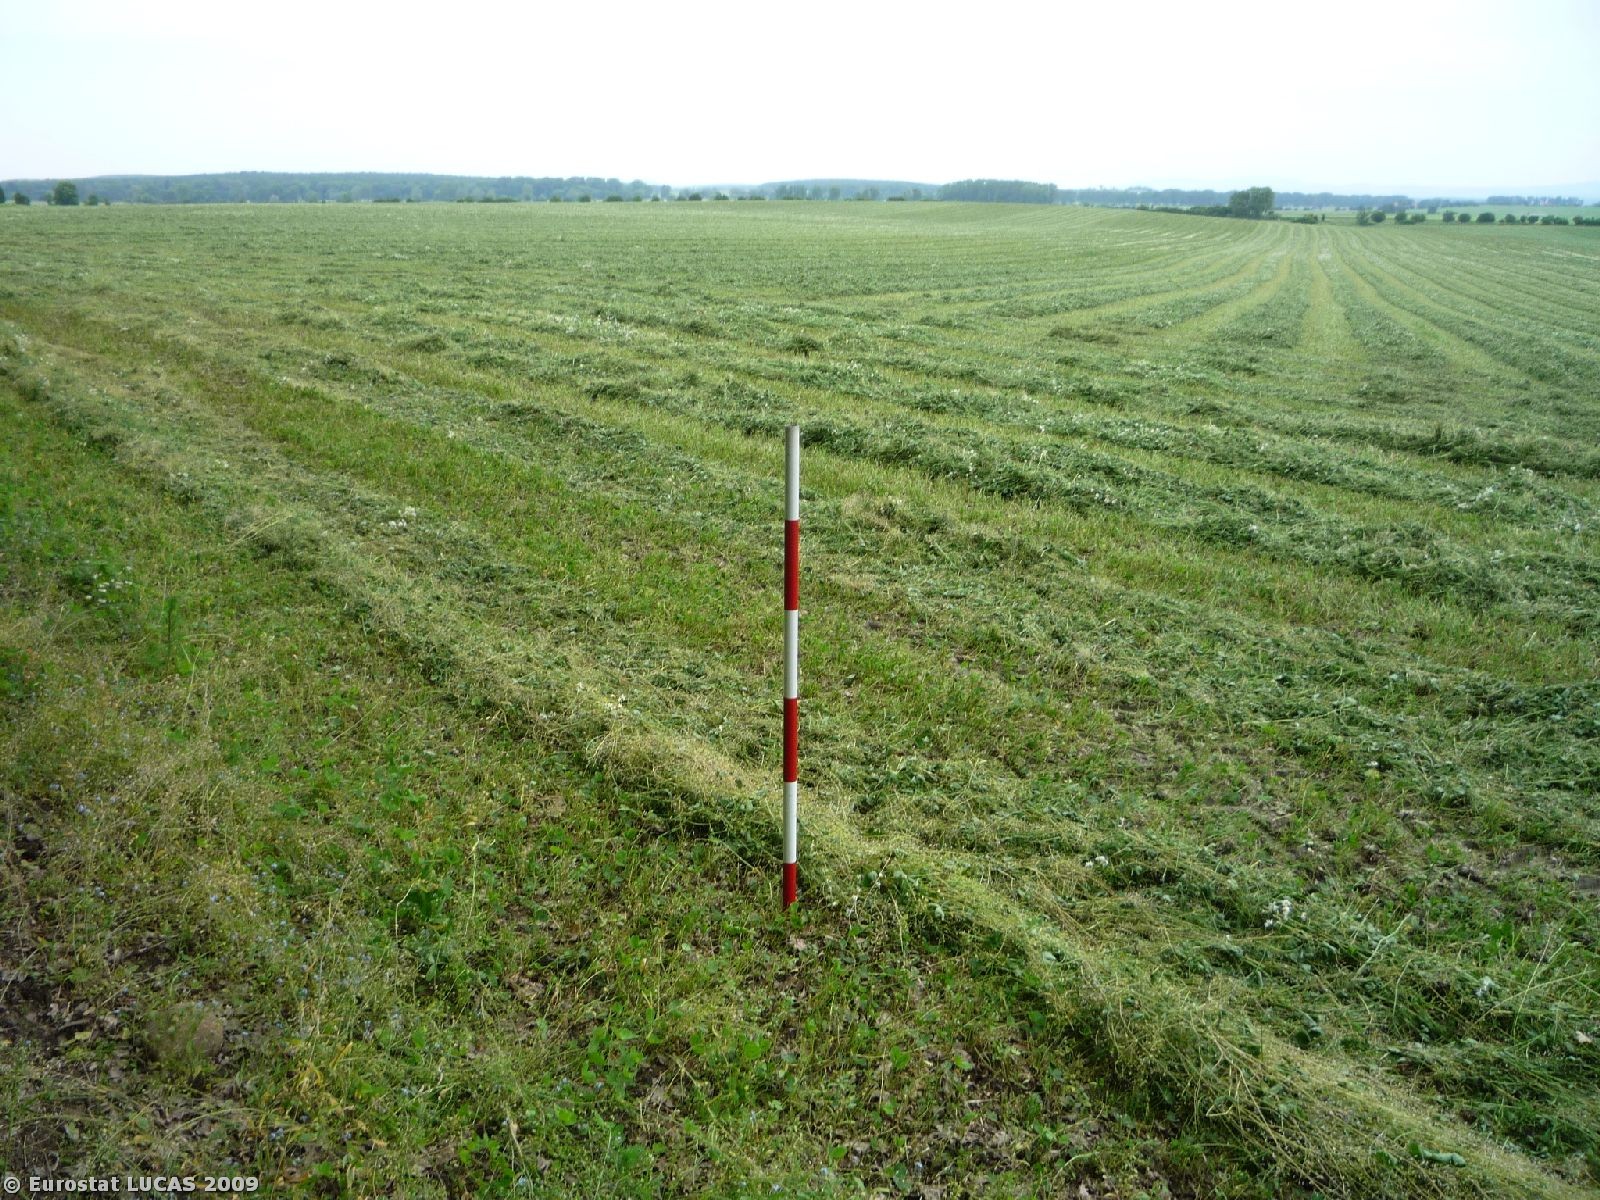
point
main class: Cropland
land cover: Clovers
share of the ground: > 75 %
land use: Agriculture (excluding fallow land and kitchen gardens)
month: May
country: CZ
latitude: 50.3028
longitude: 15.5218
